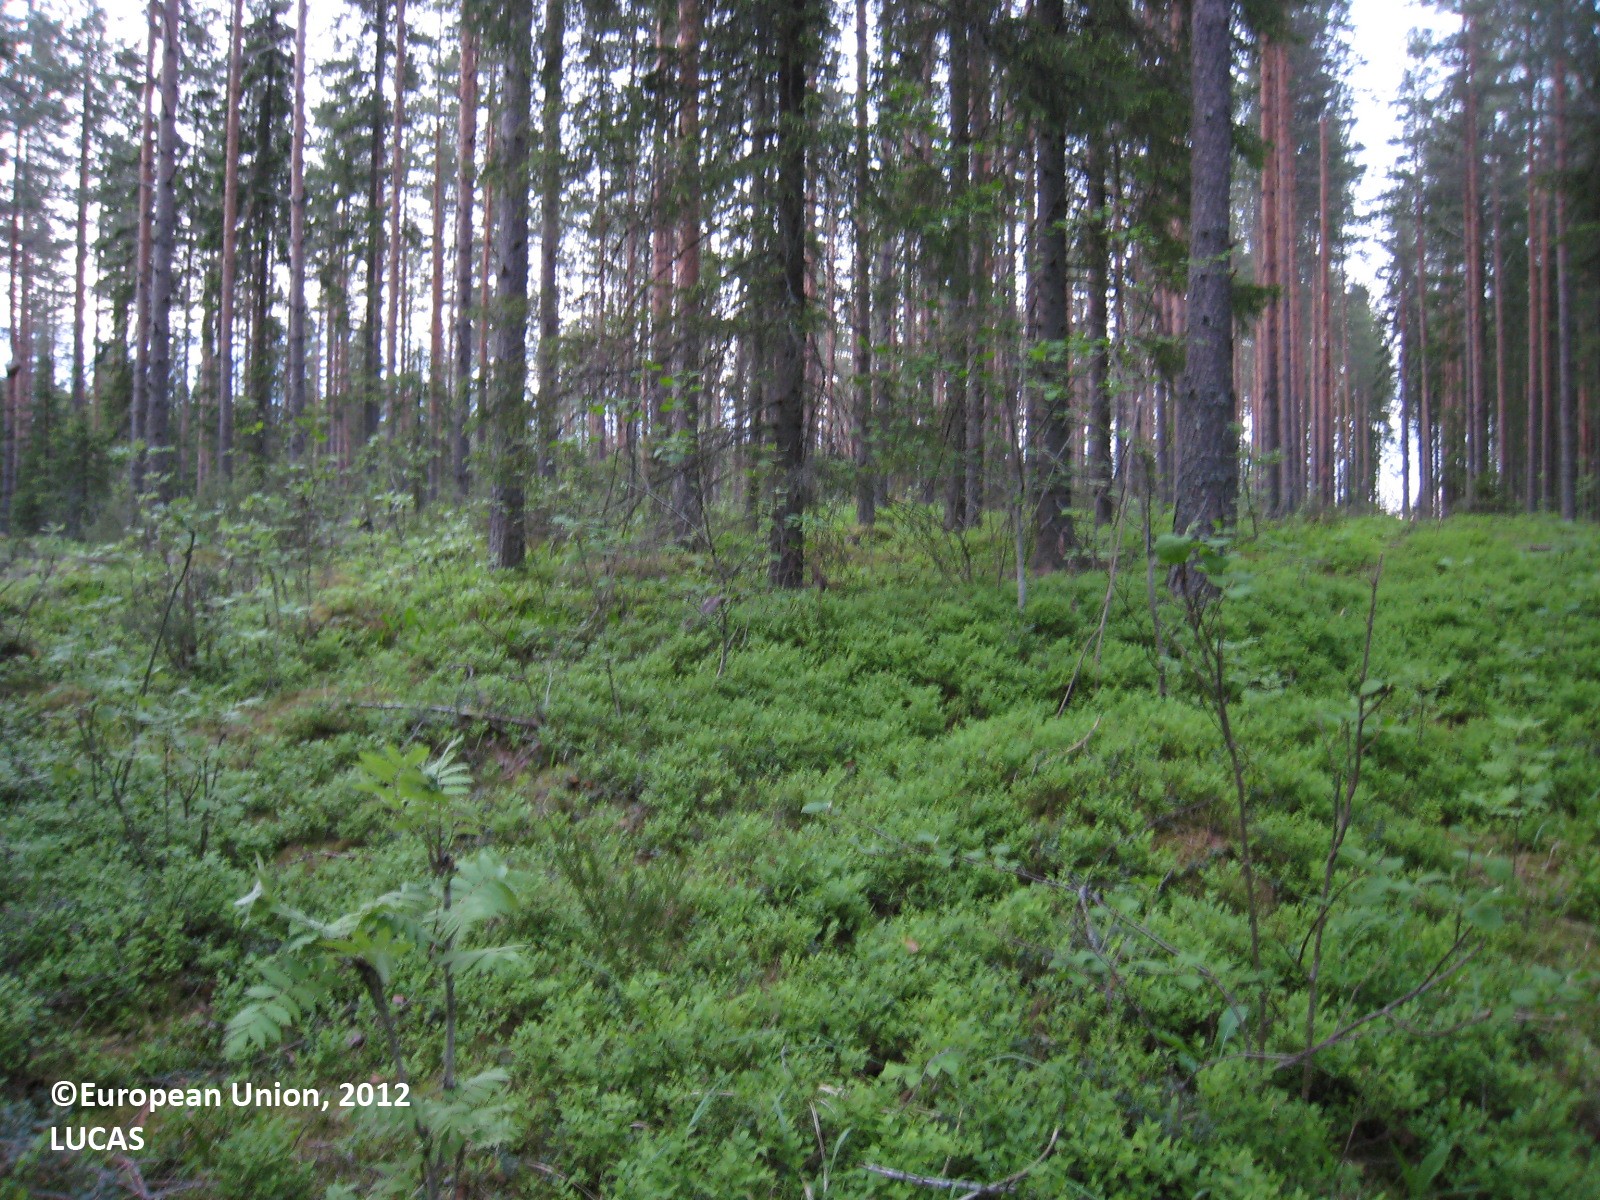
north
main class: Woodland
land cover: Pine dominated coniferous woodland
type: boreal forest
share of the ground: 50 - 75 %
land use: Forestry
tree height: > 5 m
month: June
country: FI
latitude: 62.5594
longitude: 26.0156
